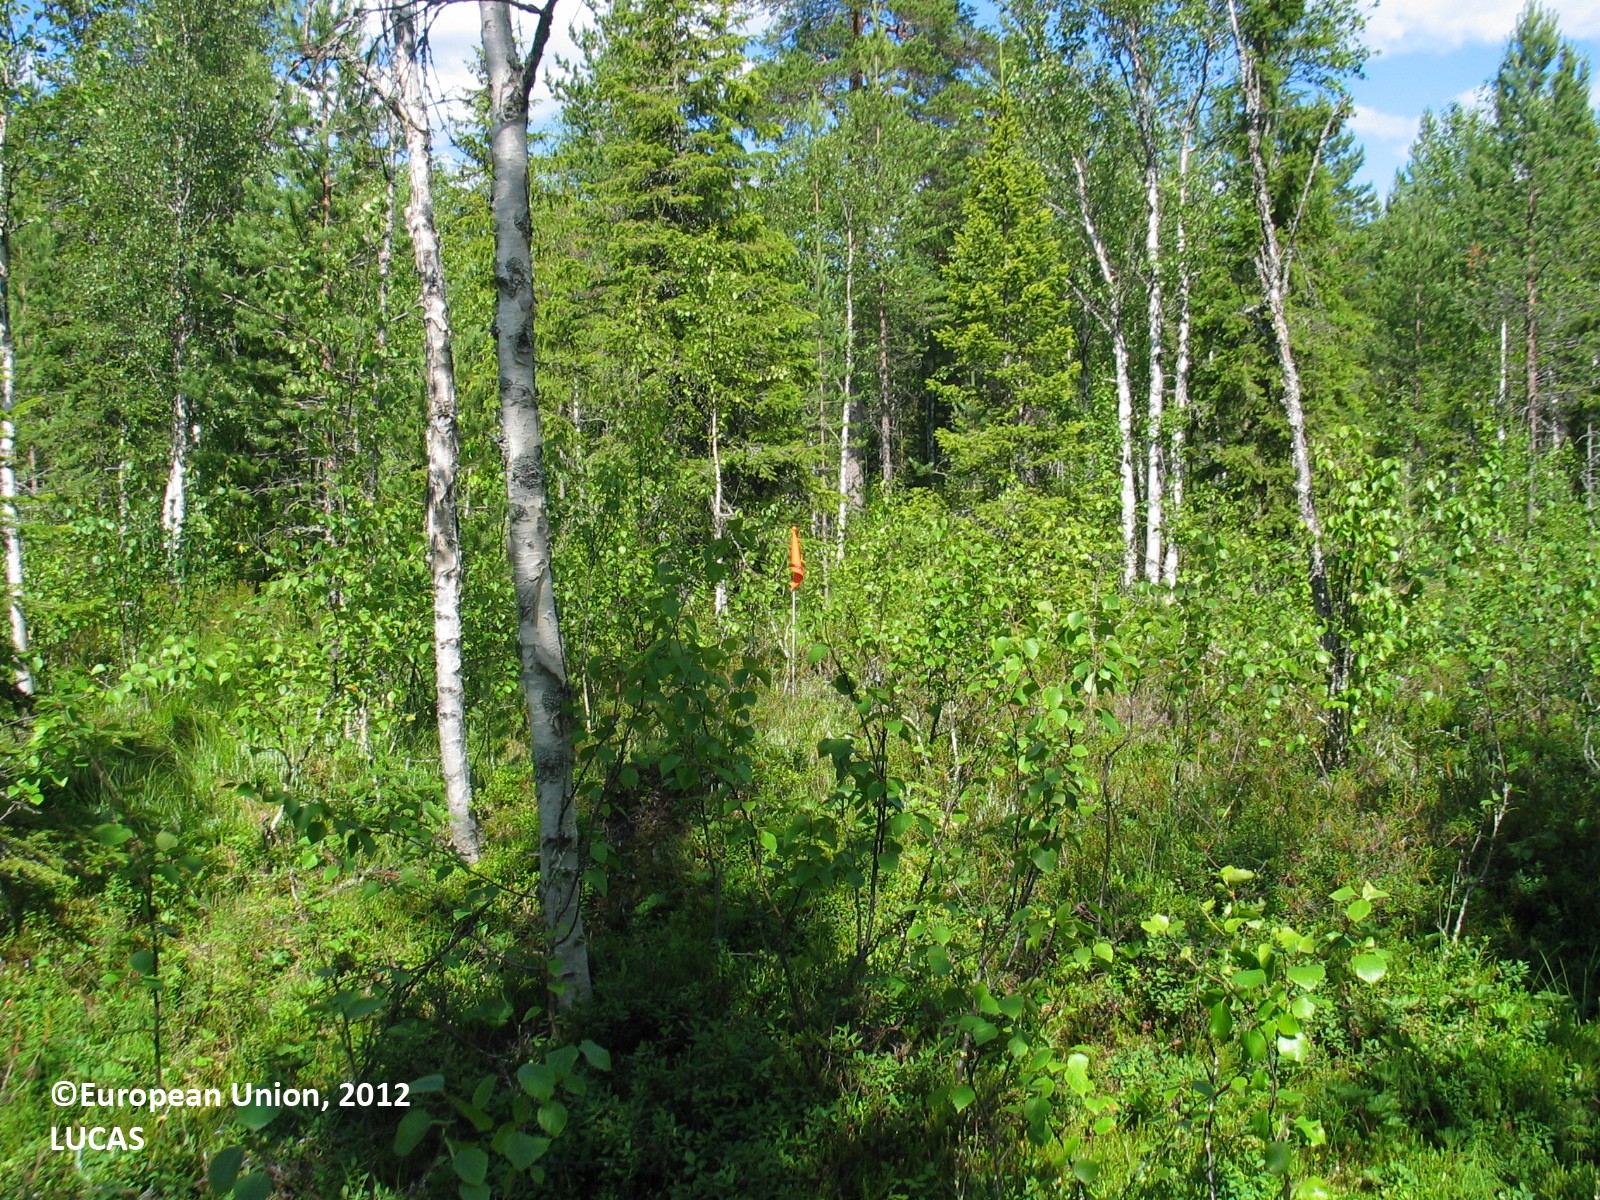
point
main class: Woodland
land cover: Other mixed woodland
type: mire and swamp forests
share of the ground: 25 - 50 %
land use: Forestry
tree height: > 5 m
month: July
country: FI
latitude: 65.9565
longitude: 24.9513
